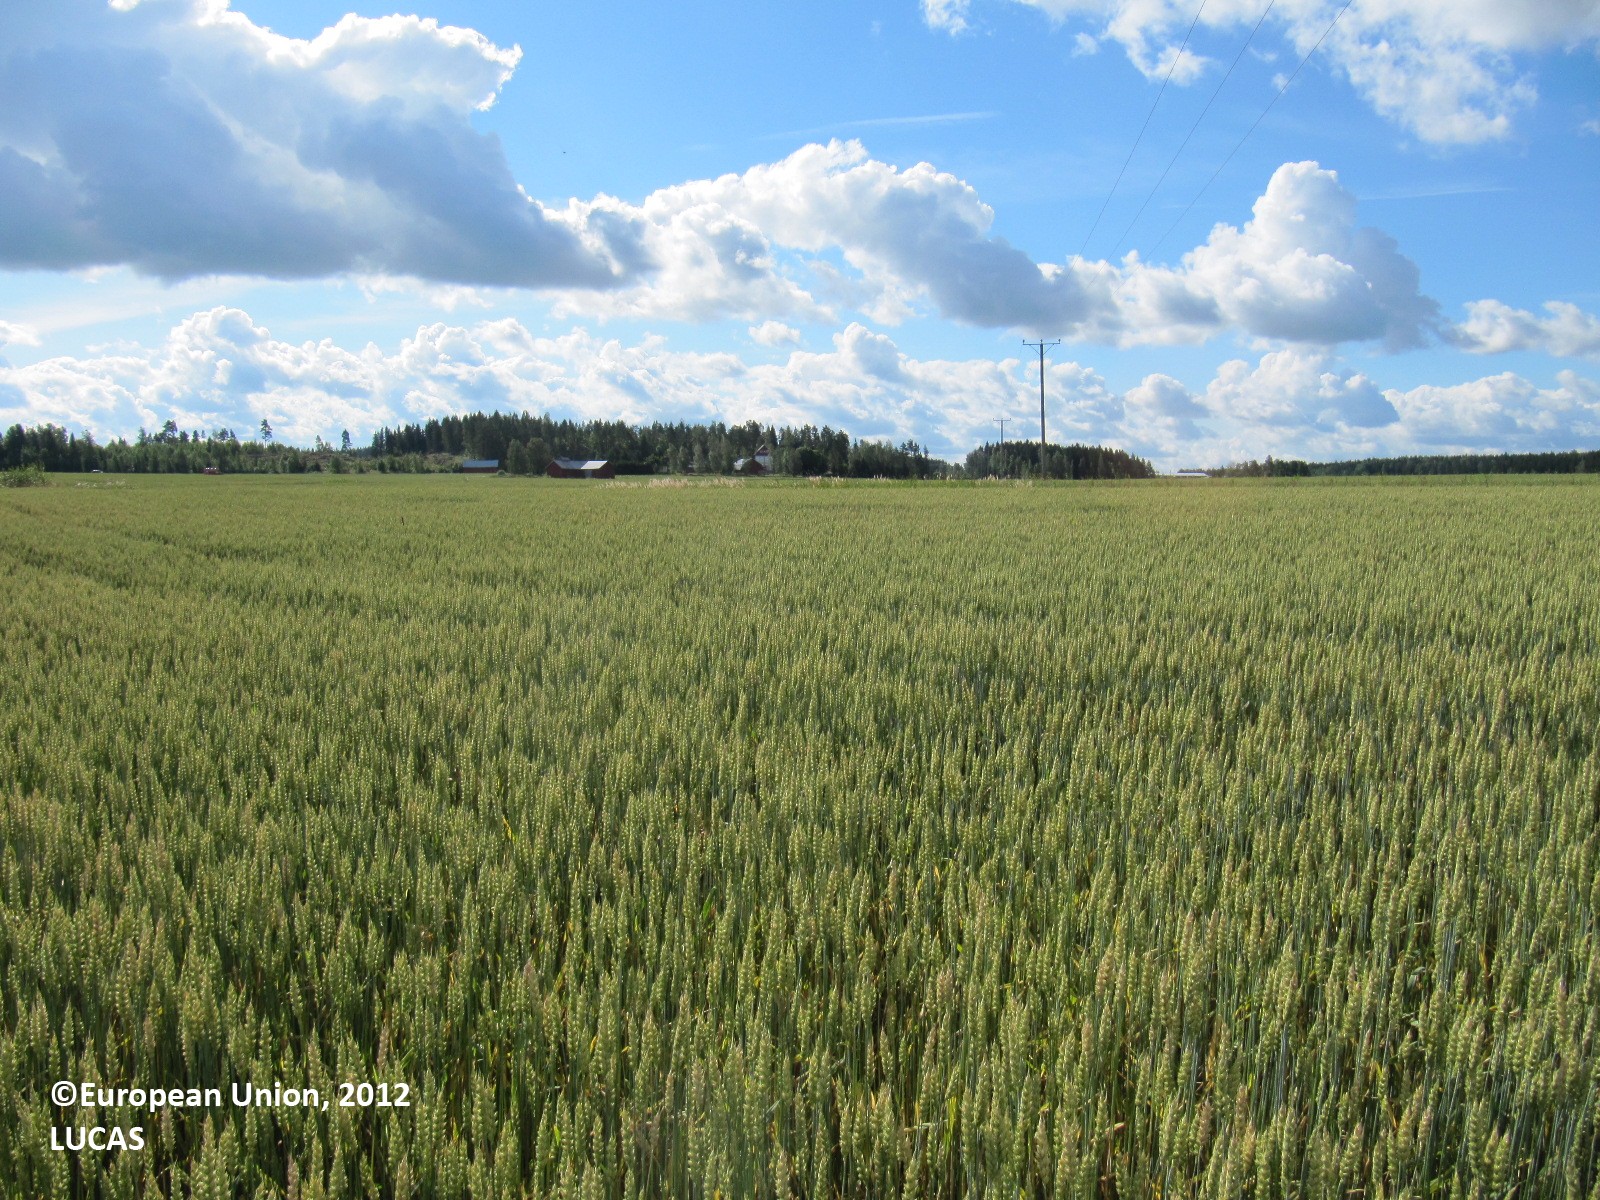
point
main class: Cropland
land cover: Common wheat
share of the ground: > 75 %
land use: Agriculture (excluding fallow land and kitchen gardens)
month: August
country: FI
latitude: 60.5103
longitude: 23.1748
